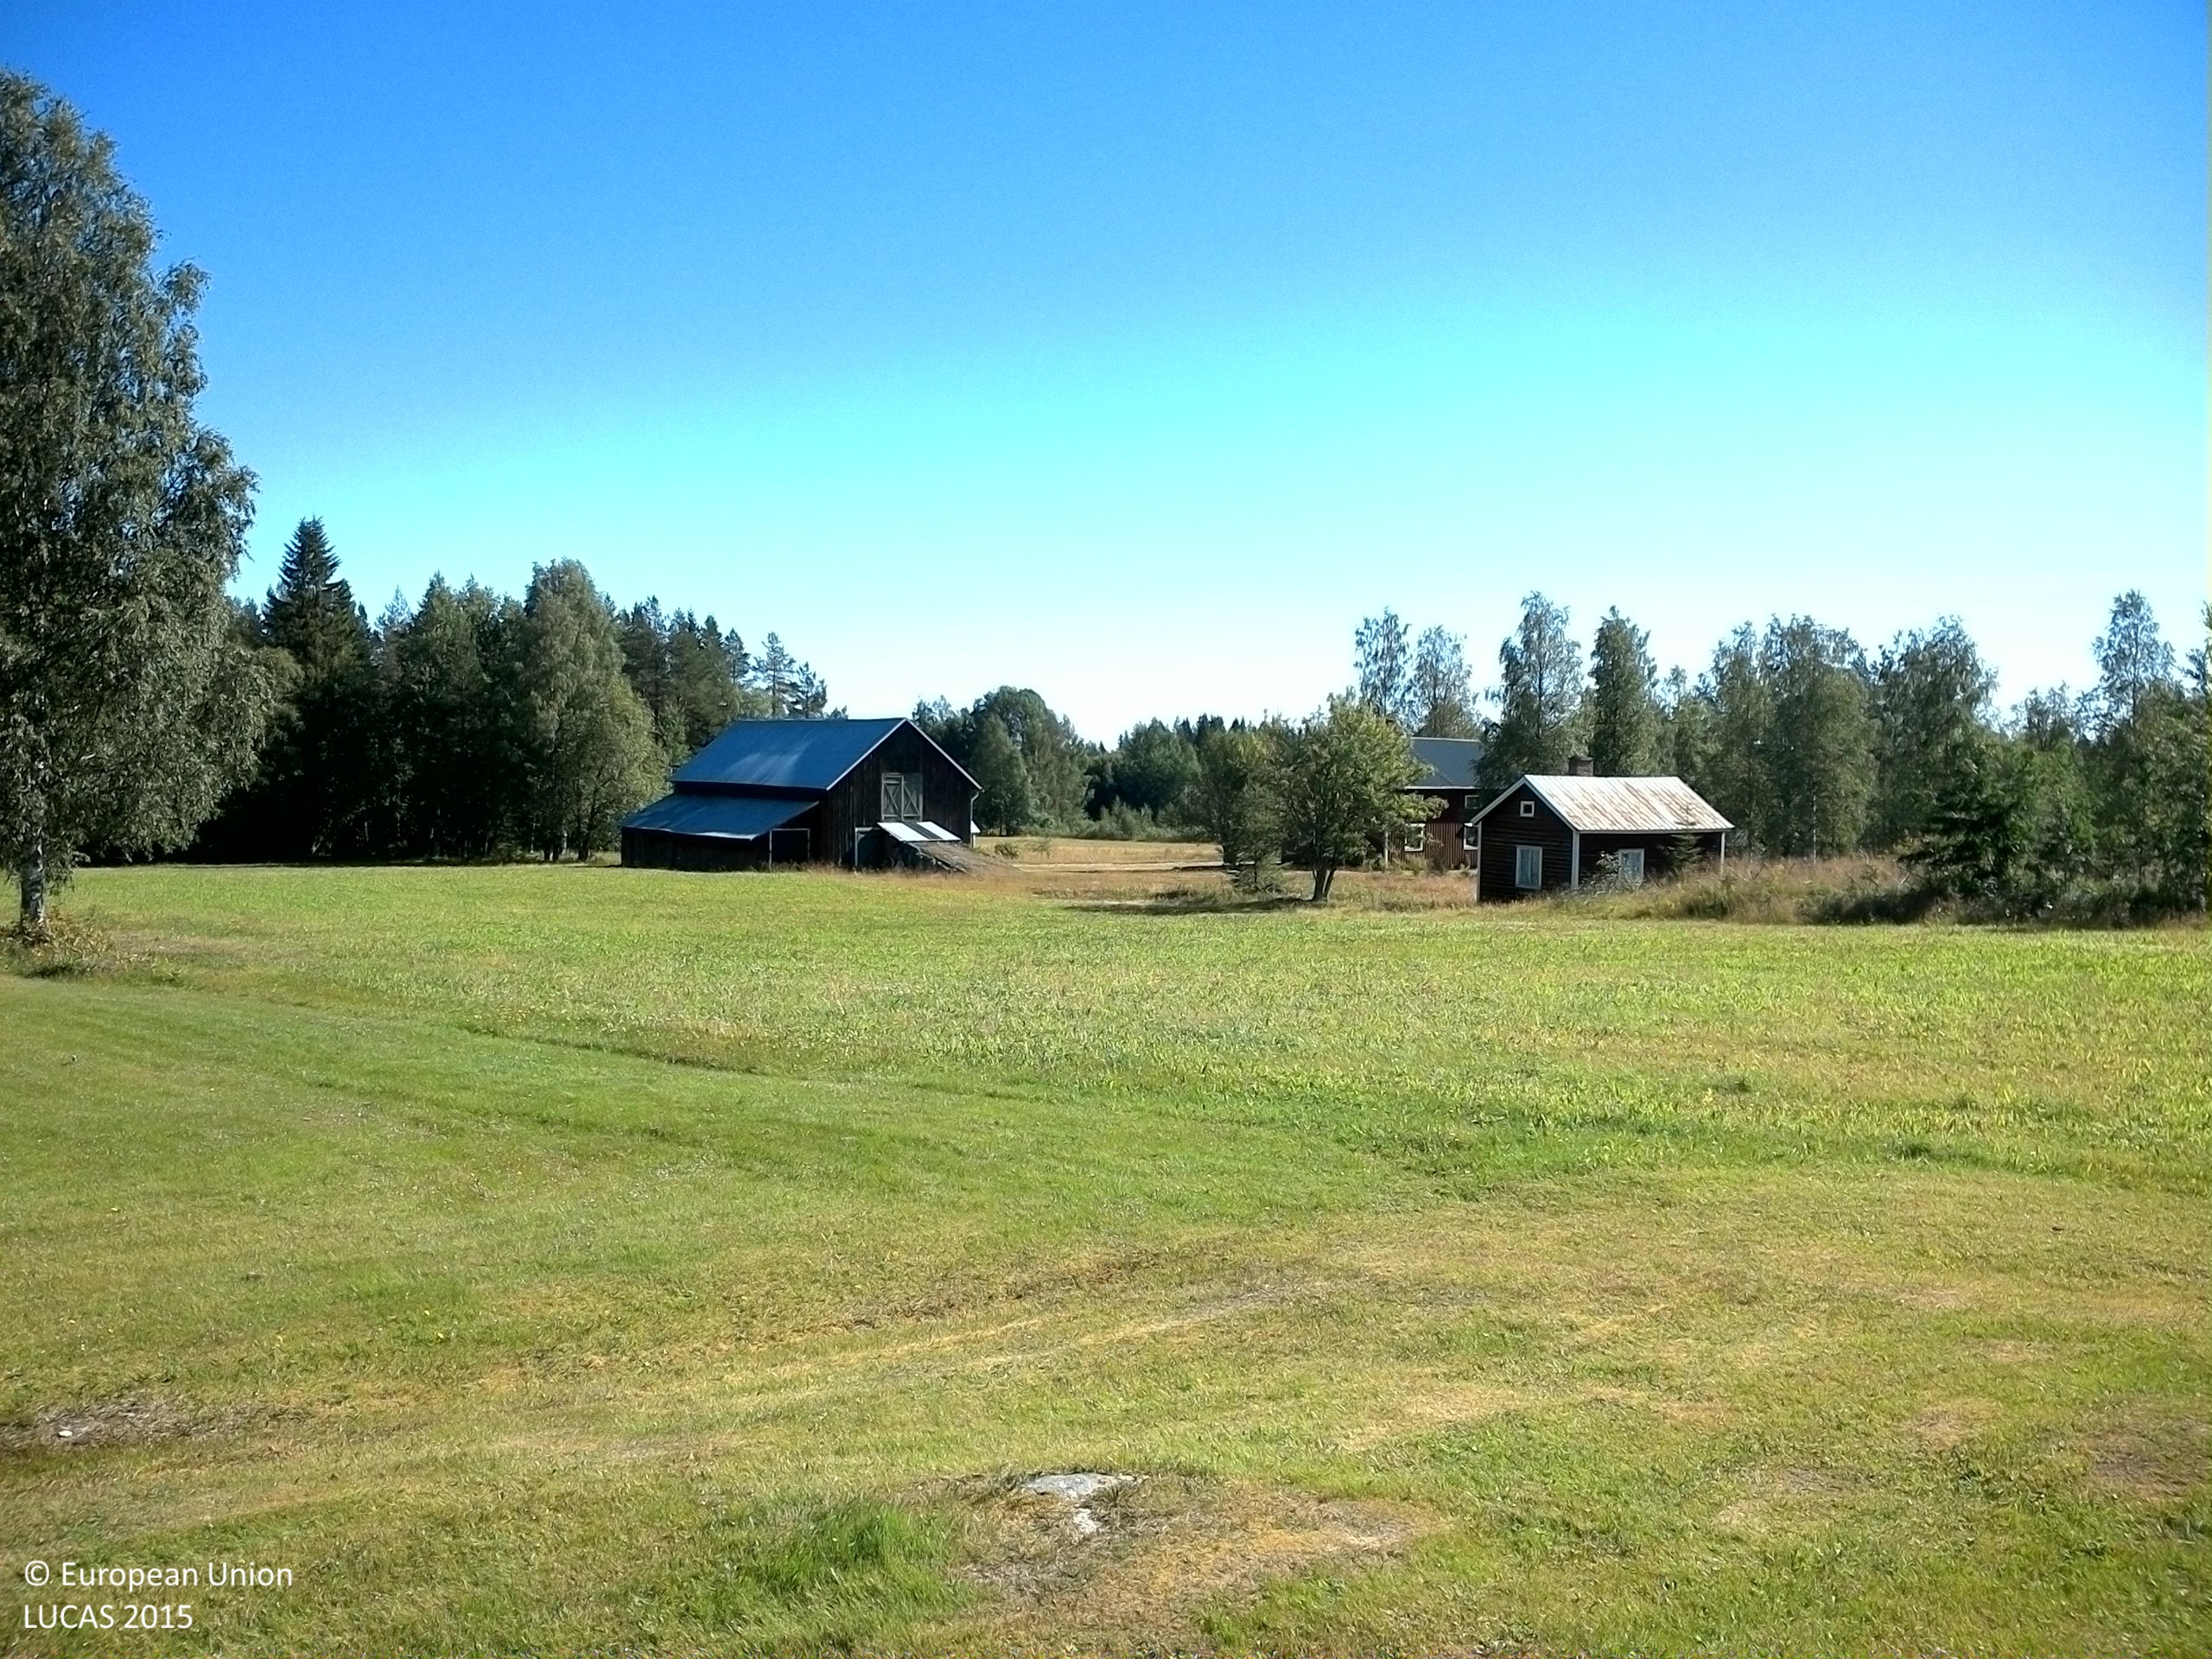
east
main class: Grassland
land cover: Grassland without tree/shrub cover
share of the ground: > 75 %
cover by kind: herbaceous plants 80 %, lichens and mosses 20 %
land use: Residential
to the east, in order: Grassland without tree/shrub cover; Grassland with sparse tree/shrub cover; Tracks; Grassland with sparse tree/shrub cover; Tracks; Ditches and canals; Temporary grasslands; Ditches and canals; Tracks; Electric lines; Pine dominated mixed woodland; Ditches and canals; Broadleaved woodland
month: August
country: SE
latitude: 63.7118
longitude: 17.8860
